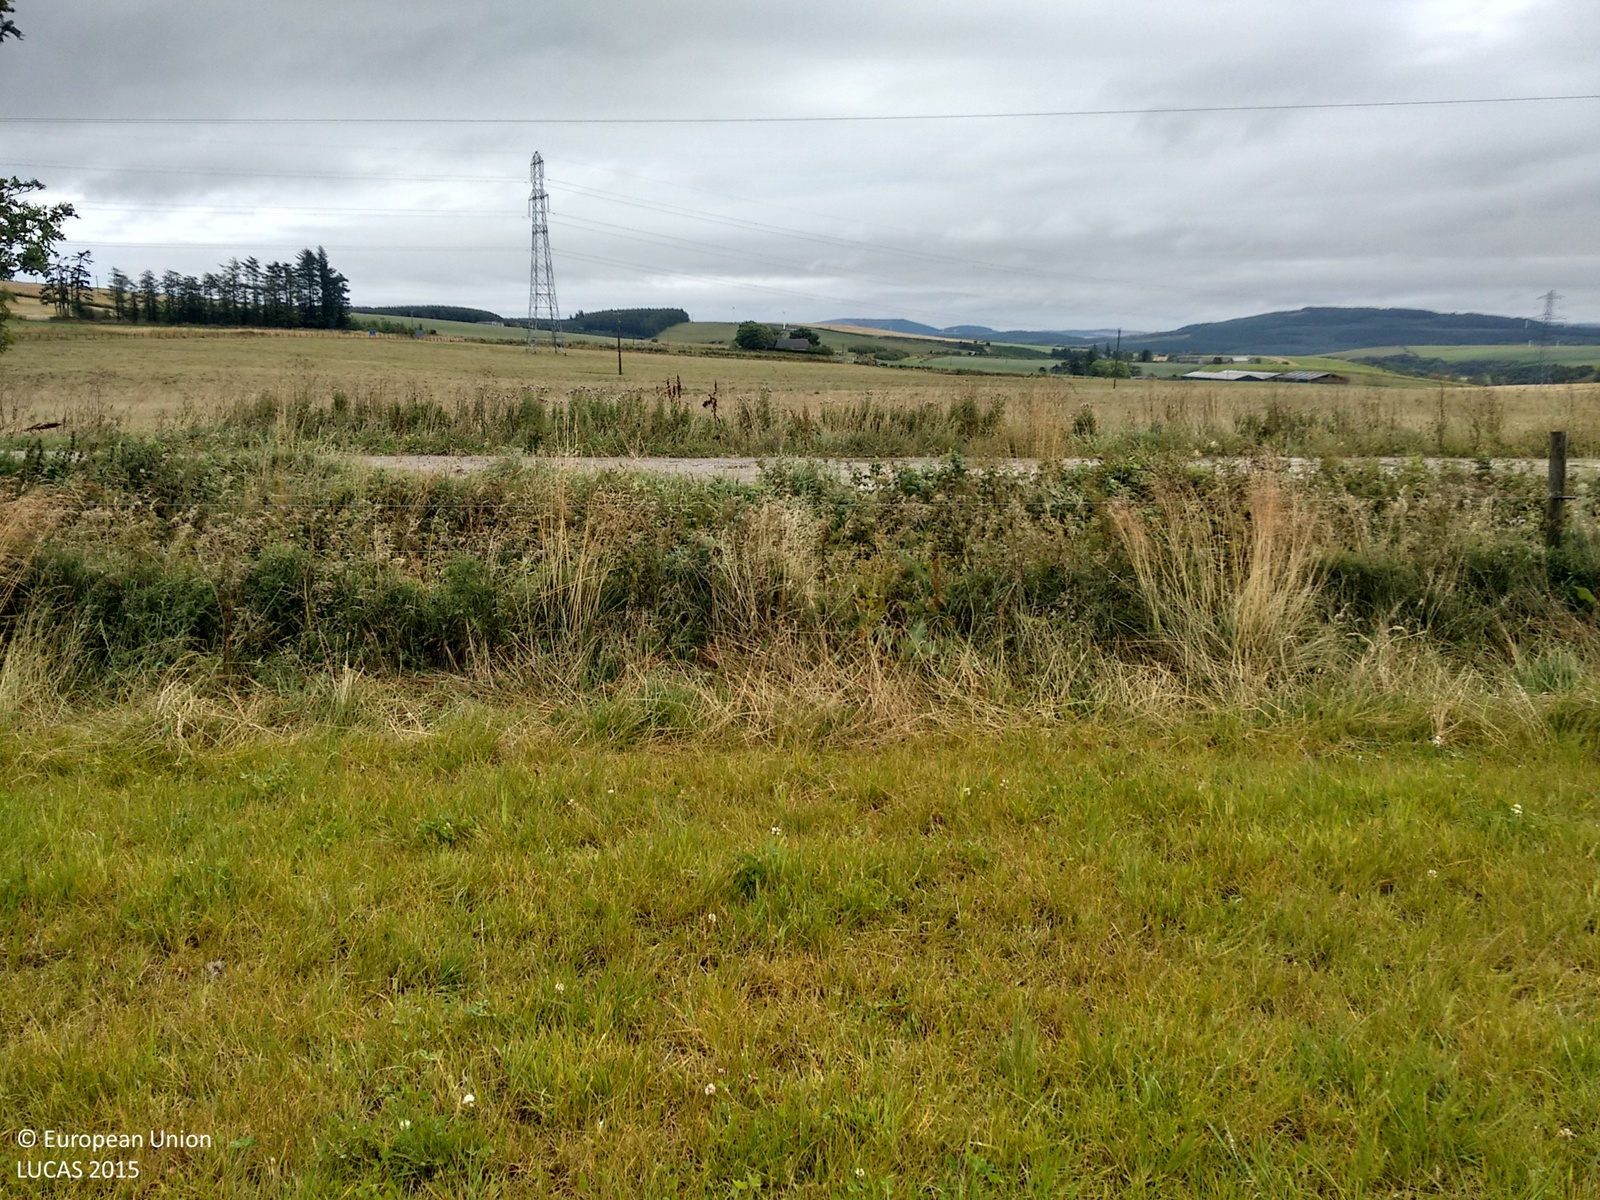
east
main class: Grassland
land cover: Grassland without tree/shrub cover
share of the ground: > 75 %
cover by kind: herbaceous plants 95 %, unconsolidated bare surface 5 %
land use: Agriculture (excluding fallow land and kitchen gardens)
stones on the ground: 10 - 25 %
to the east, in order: Grassland without tree/shrub cover; Fences; Shruby margins; Ditches and canals; Shruby margins; Paved roads, cycling and walking lanes; Shruby margins; Electric lines; Fences; Grassland without tree/shrub cover; Electric lines; Grassland without tree/shrub cover
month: September
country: GB
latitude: 57.5006
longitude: -2.9259
